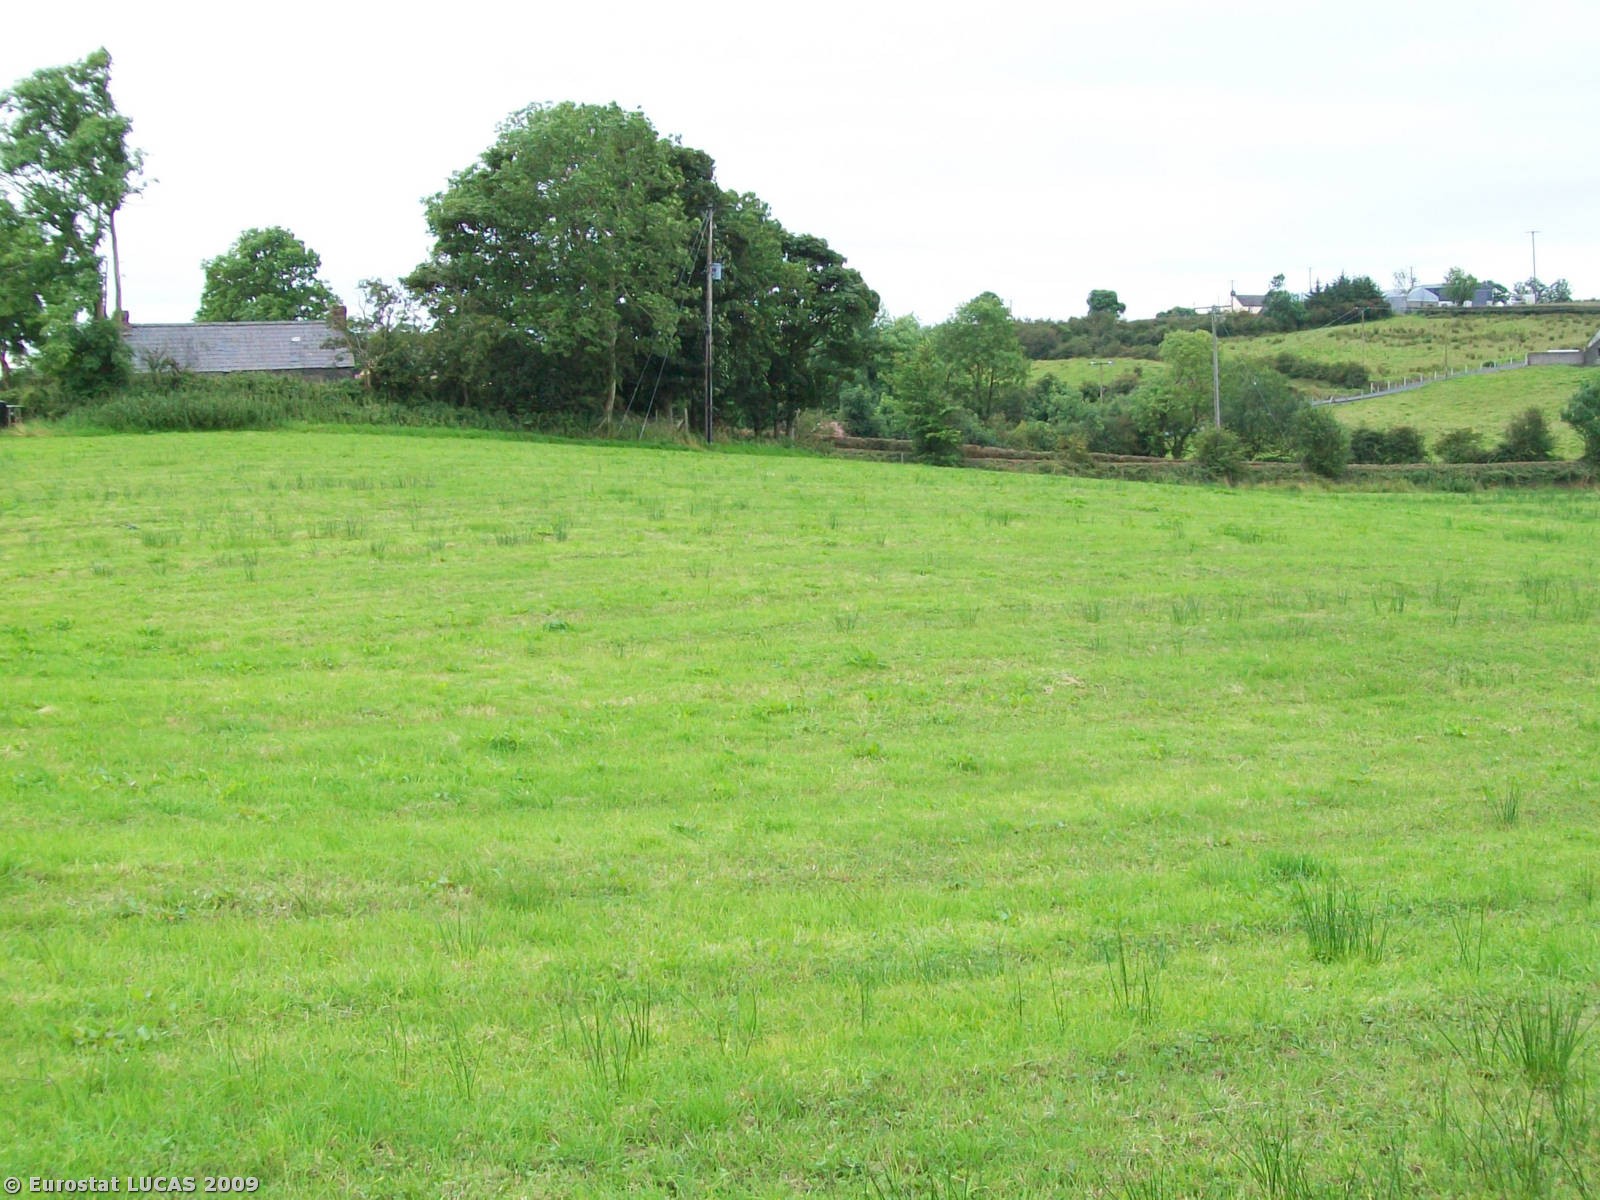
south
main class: Grassland
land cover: Grassland without tree/shrub cover
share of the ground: > 75 %
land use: Agriculture (excluding fallow land and kitchen gardens)
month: August
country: GB
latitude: 54.1271
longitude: -6.5461
